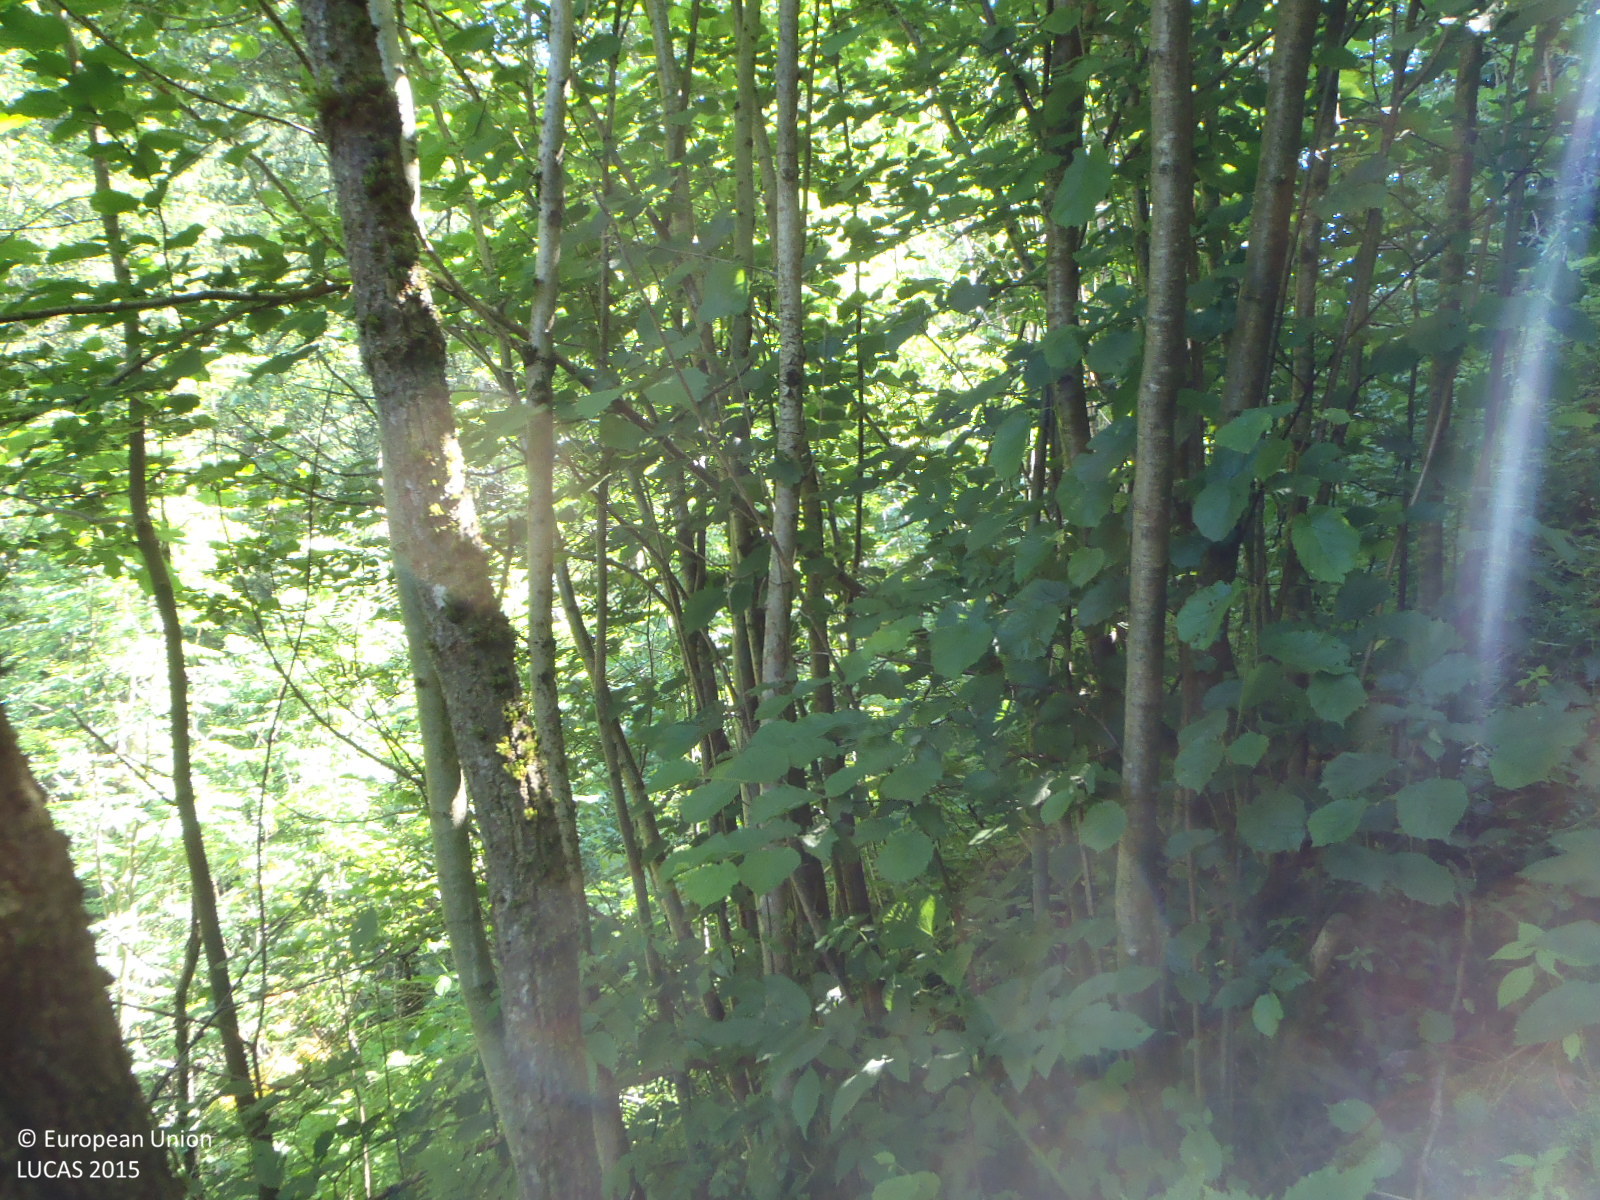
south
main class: Woodland
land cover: Broadleaved woodland
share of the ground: > 75 %
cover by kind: broadleaved forest trees 80 %, coniferous forest trees 10 %, herbaceous plants 5 %, lichens and mosses 5 %
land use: Forestry
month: July
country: AT
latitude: 47.3867
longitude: 12.4224
